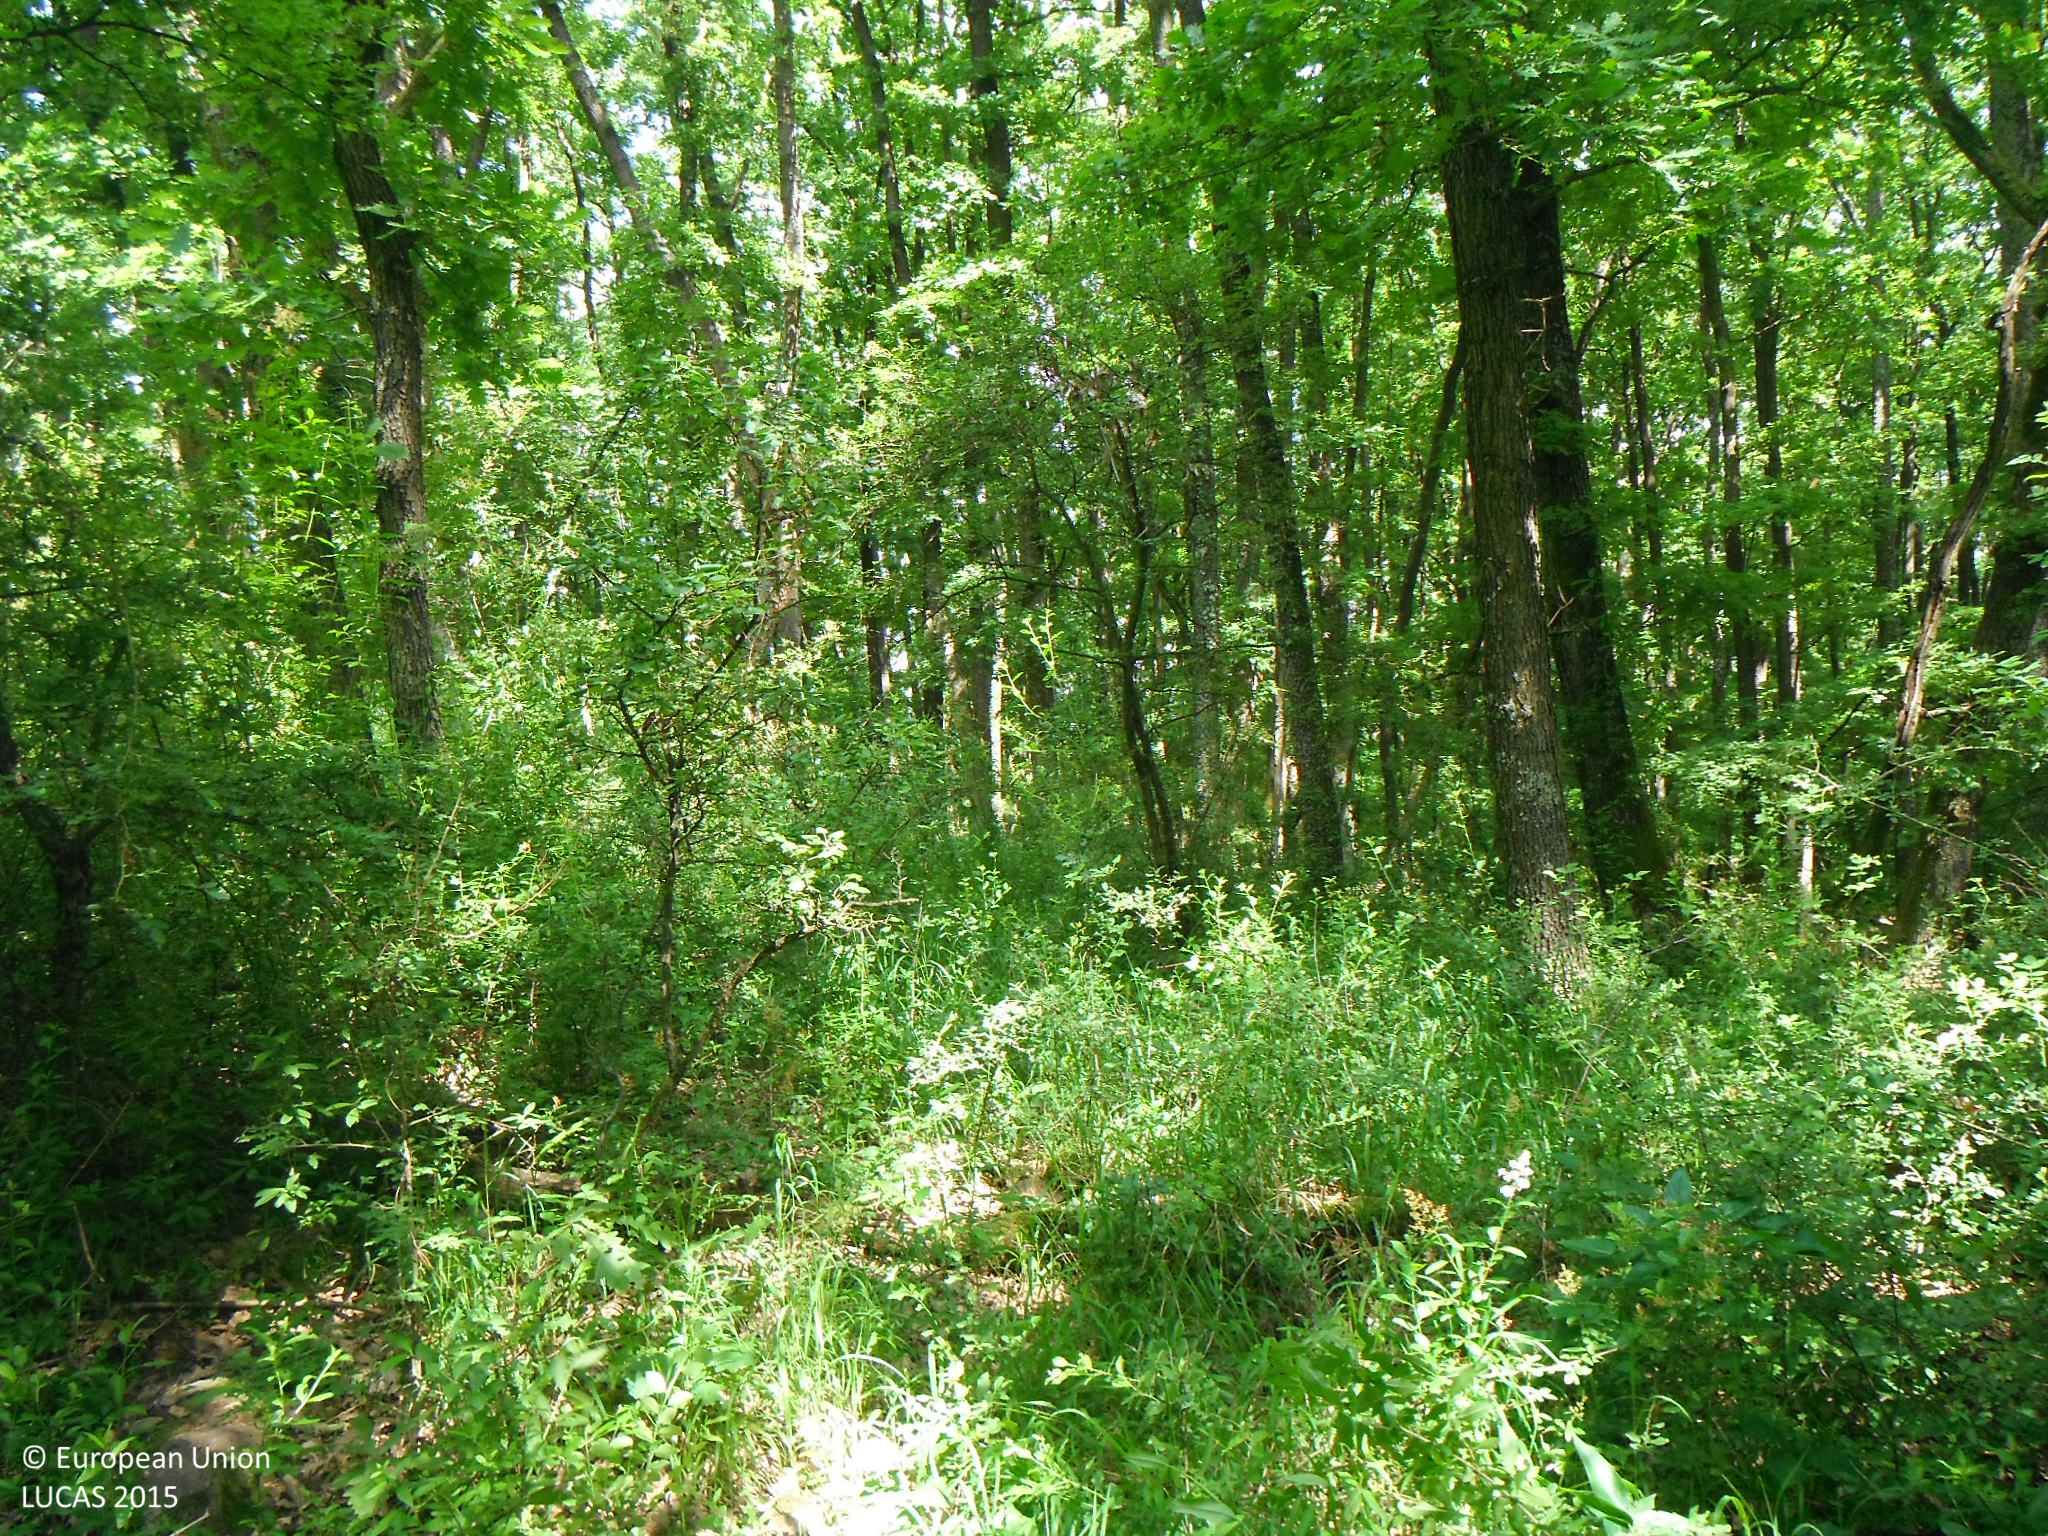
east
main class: Woodland
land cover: Broadleaved woodland
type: acidophilous oak and oak-birch forest
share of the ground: > 75 %
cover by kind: broadleaved forest trees 80 %, shrubs 15 %, herbaceous plants 5 %
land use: Forestry
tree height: > 5 m
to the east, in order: Broadleaved woodland; Pine dominated mixed woodland; Broadleaved woodland
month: June
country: SK
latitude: 48.3015
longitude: 19.5016
